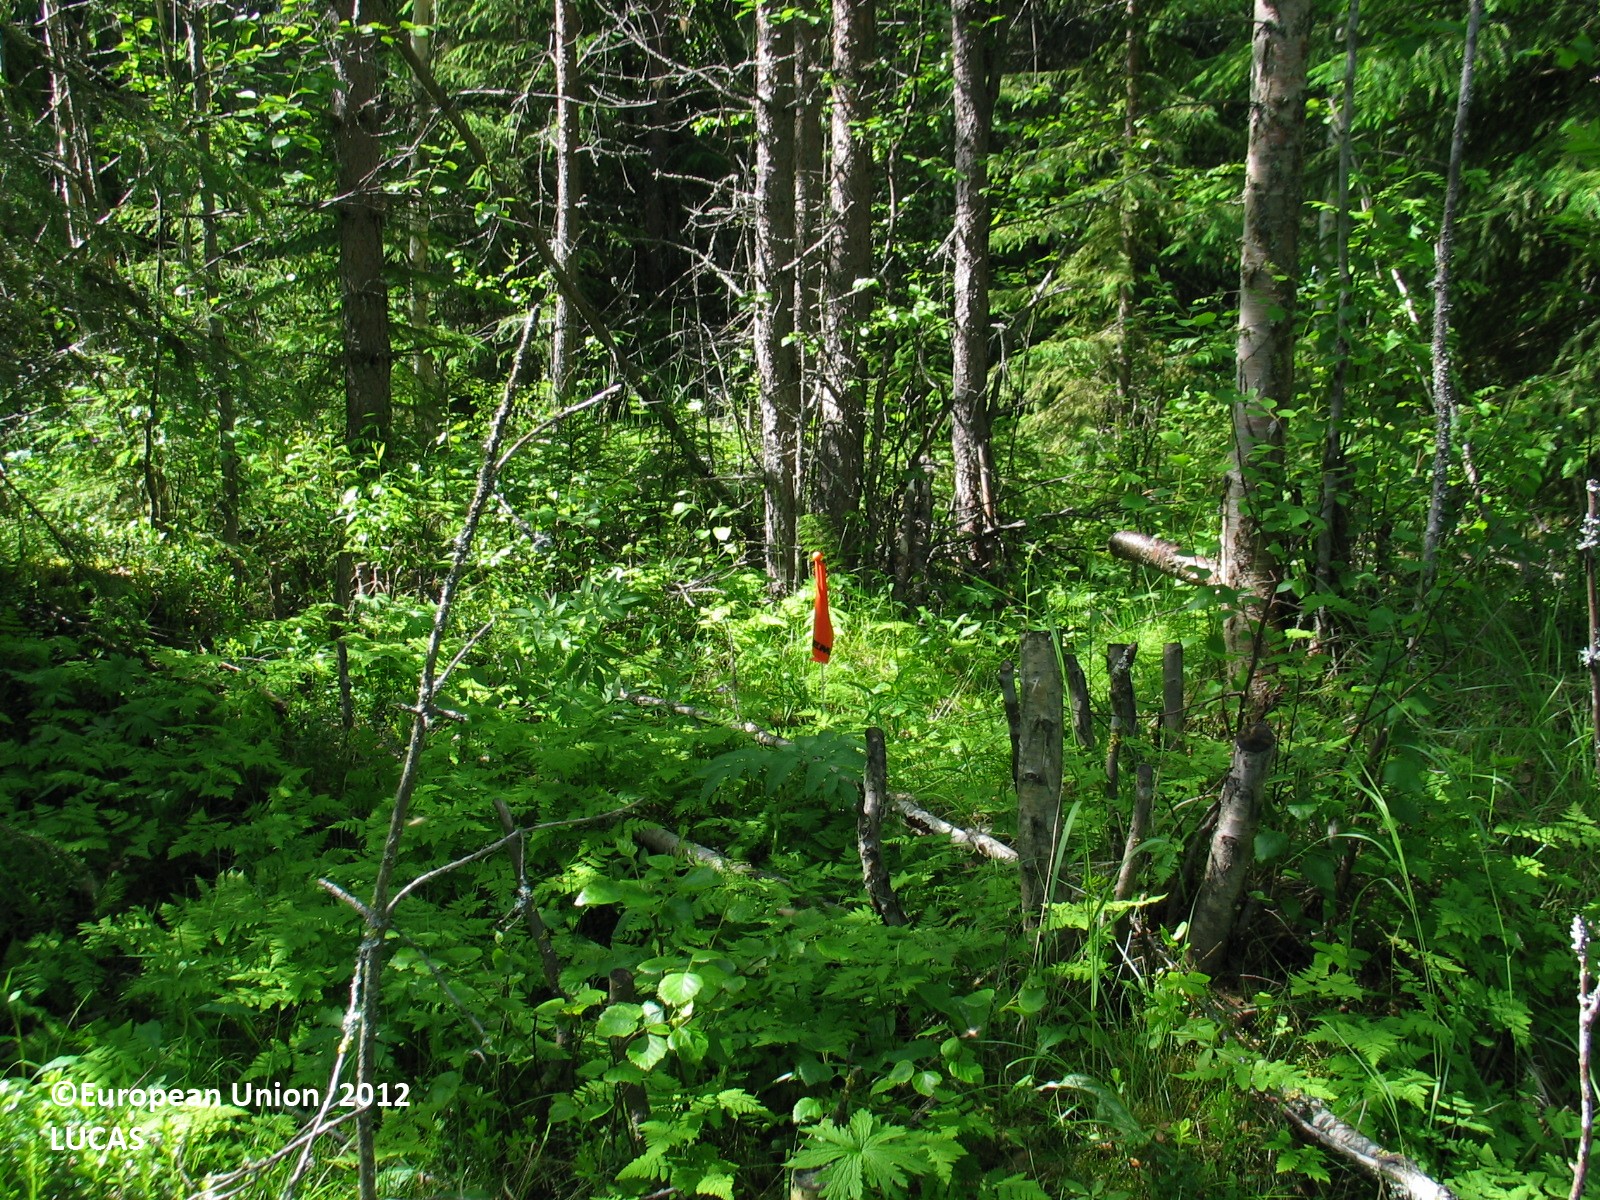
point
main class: Woodland
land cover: Other mixed woodland
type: boreal forest
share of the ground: > 75 %
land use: Forestry
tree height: > 5 m
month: July
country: FI
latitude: 64.7214
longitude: 26.5900
